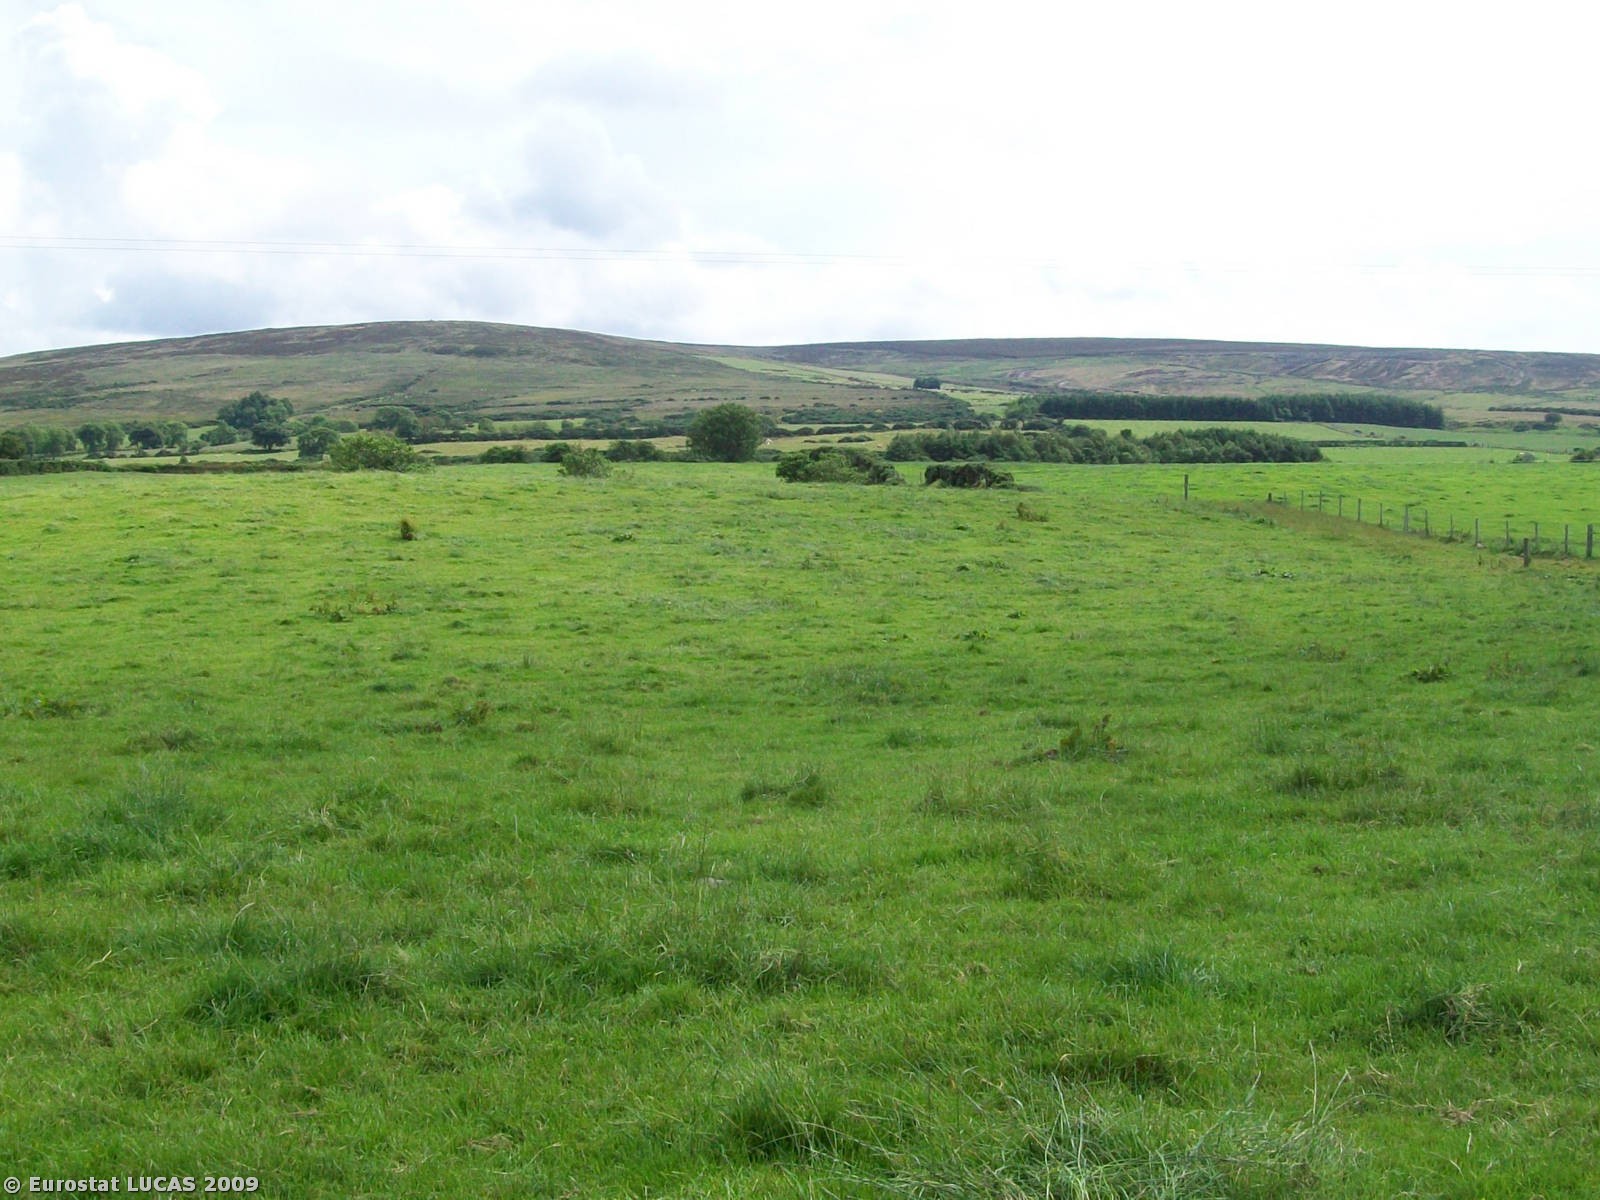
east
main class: Grassland
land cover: Grassland without tree/shrub cover
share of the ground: > 75 %
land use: Agriculture (excluding fallow land and kitchen gardens)
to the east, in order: Grassland without tree/shrub cover; Electric lines; Grassland without tree/shrub cover; Managed hedges; Fences; Grassland without tree/shrub cover; Fences; Abandoned hedges; Grassland without tree/shrub cover
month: July
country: GB
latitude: 55.1148
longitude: -6.3119
